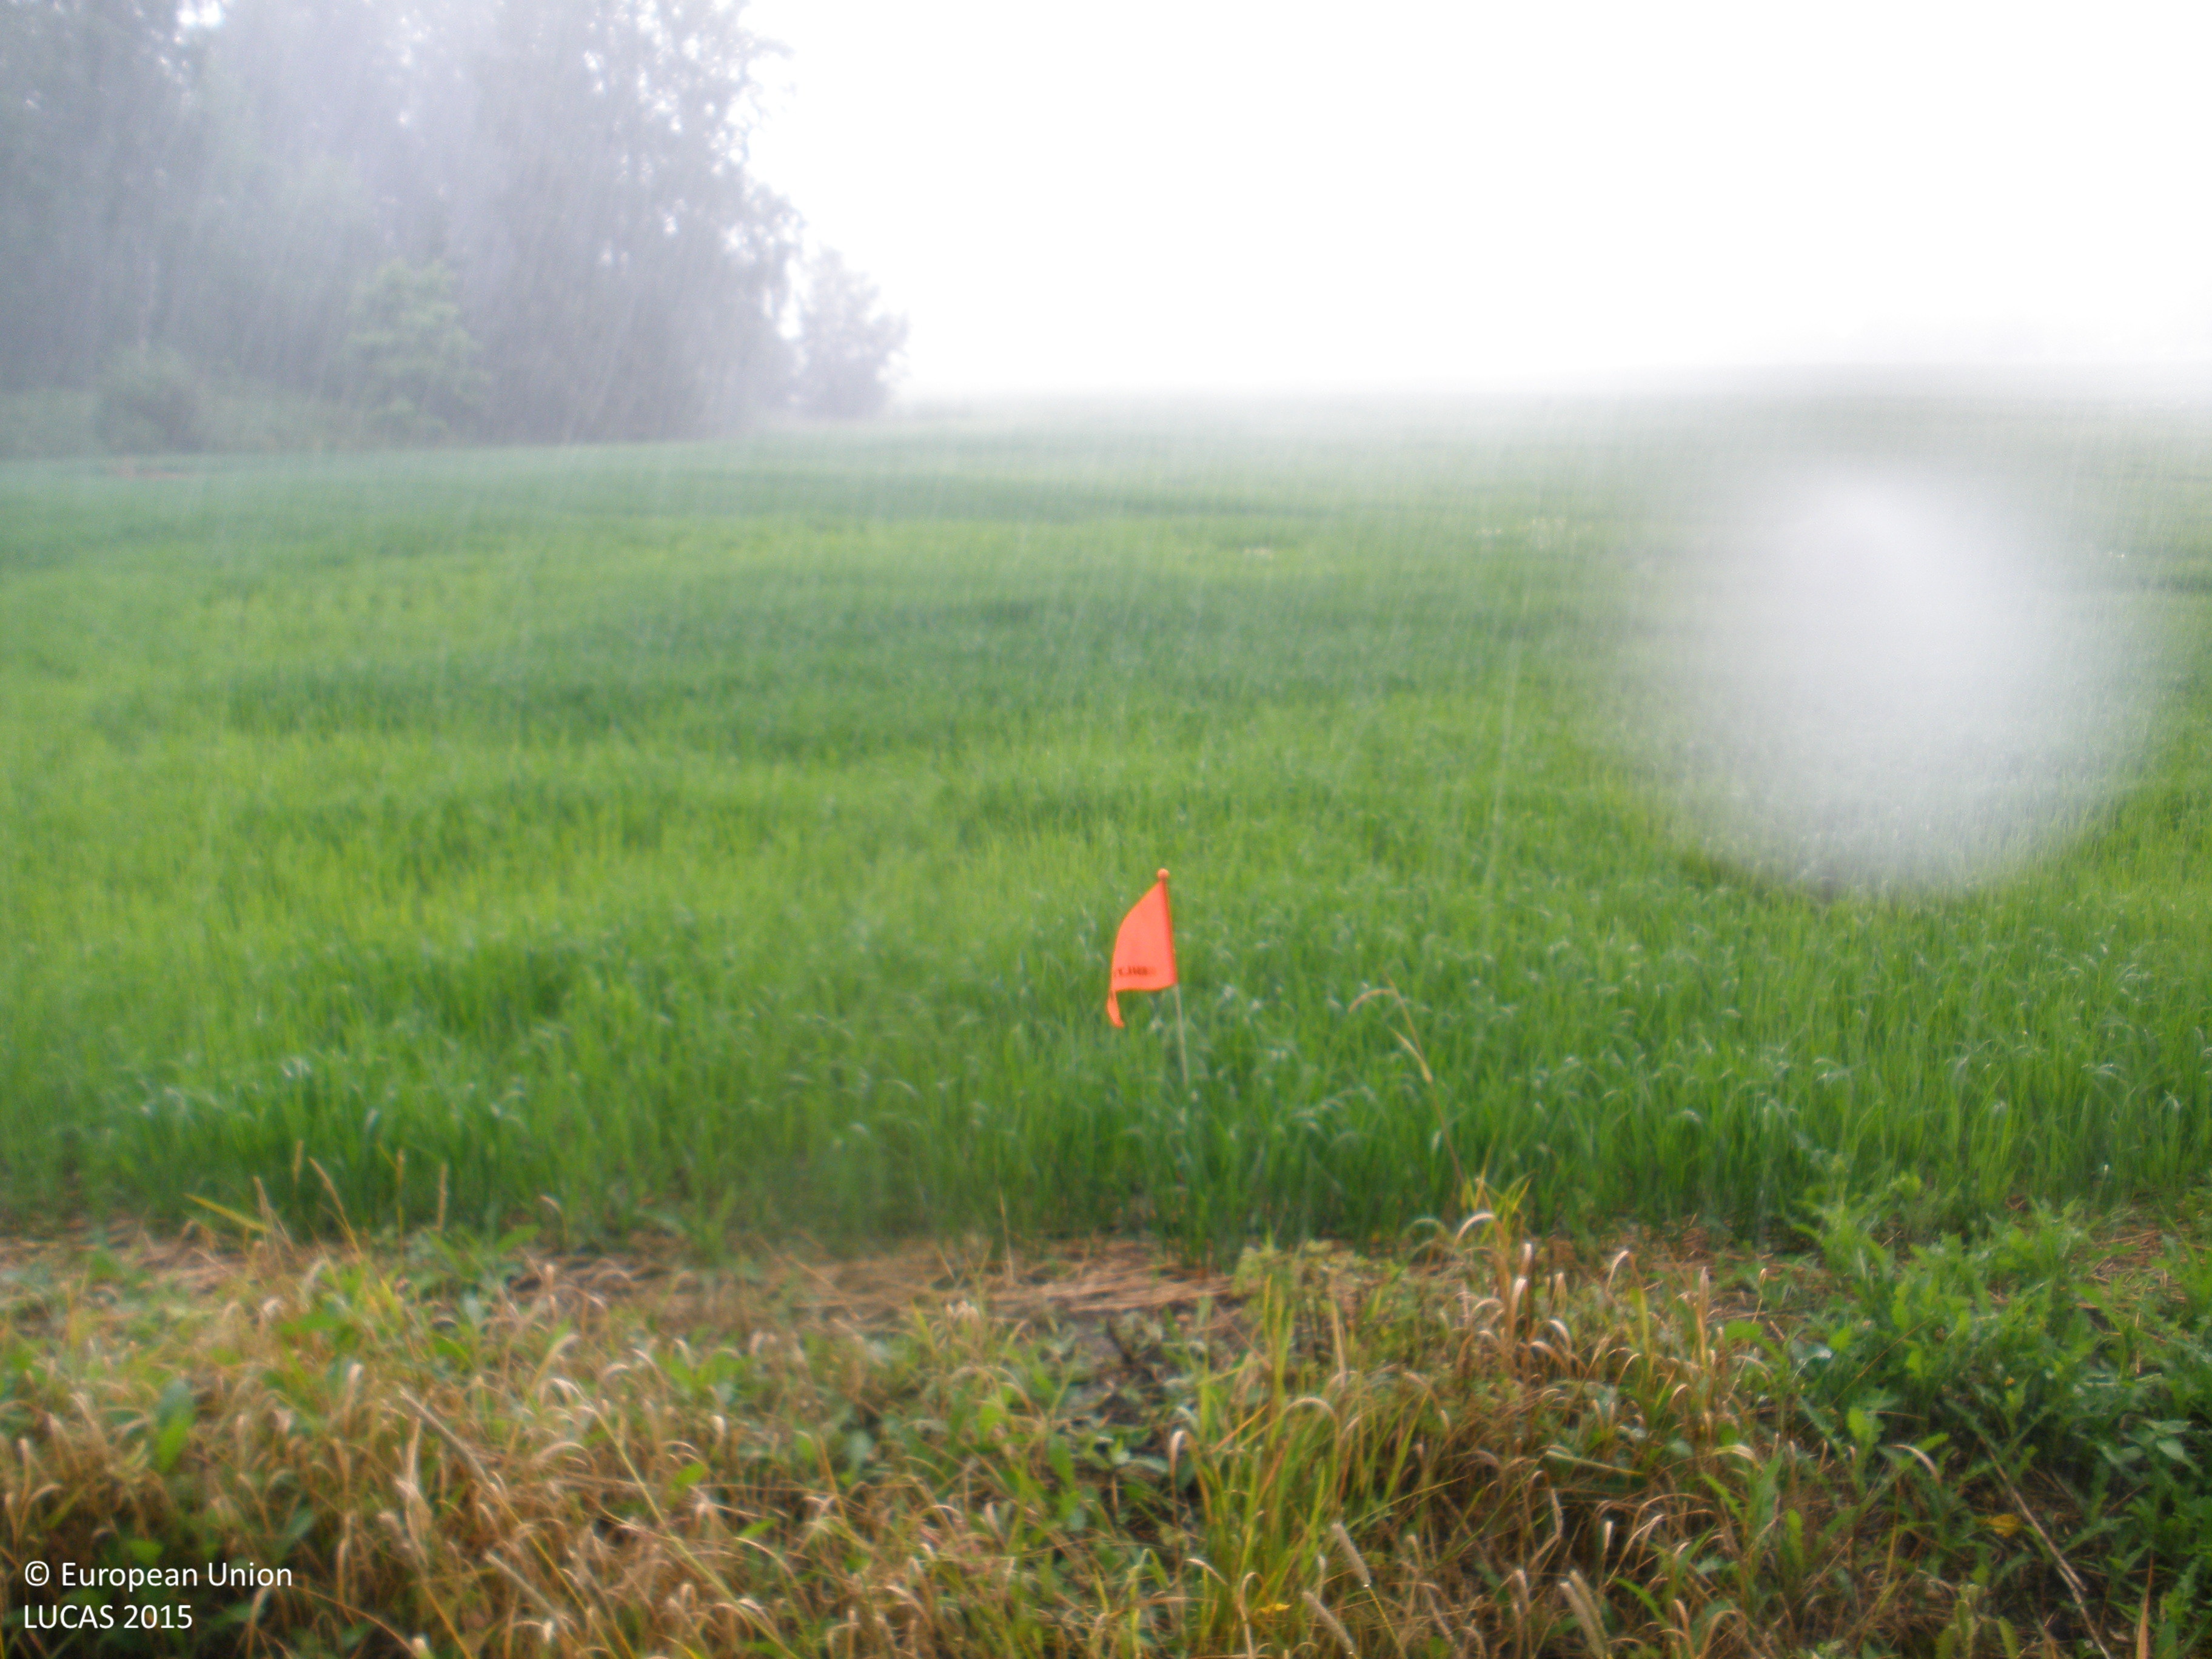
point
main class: Cropland
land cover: Oats
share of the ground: > 75 %
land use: Agriculture (excluding fallow land and kitchen gardens)
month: July
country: FI
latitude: 61.3182
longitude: 23.7386
